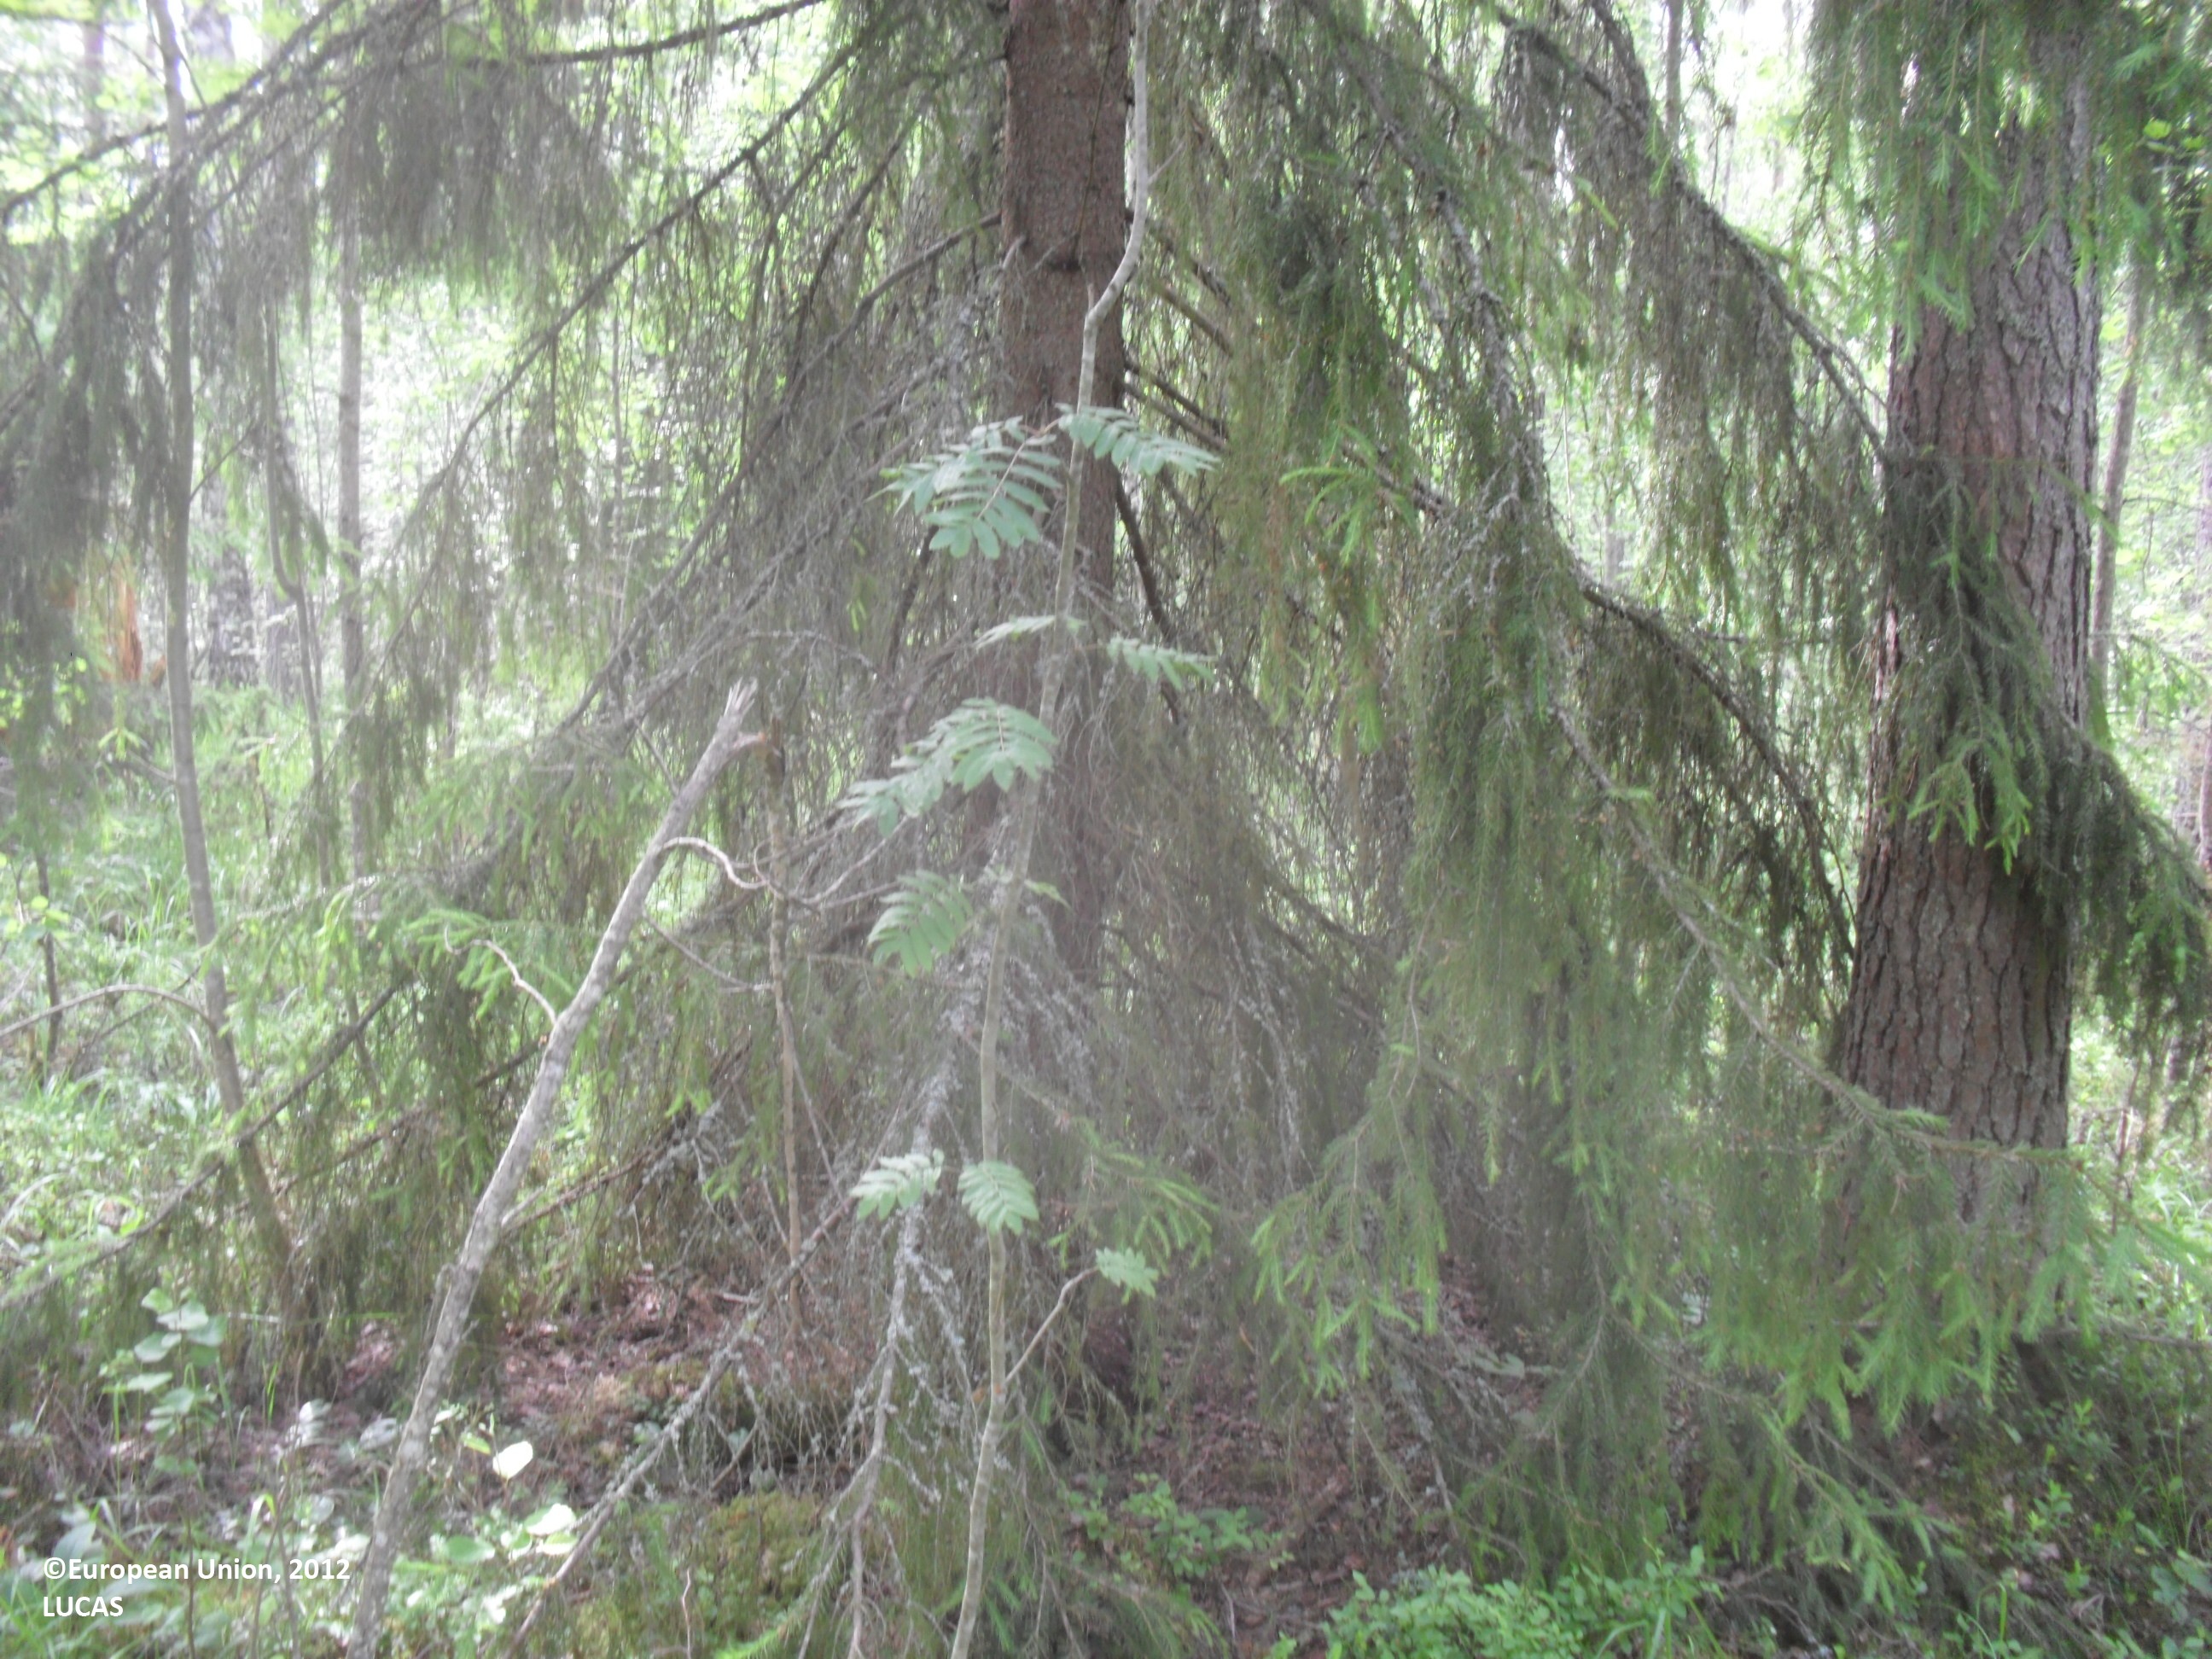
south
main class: Woodland
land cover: Other mixed woodland
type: boreal forest
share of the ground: > 75 %
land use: Forestry
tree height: > 5 m
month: June
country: FI
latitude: 62.8079
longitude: 23.7042
